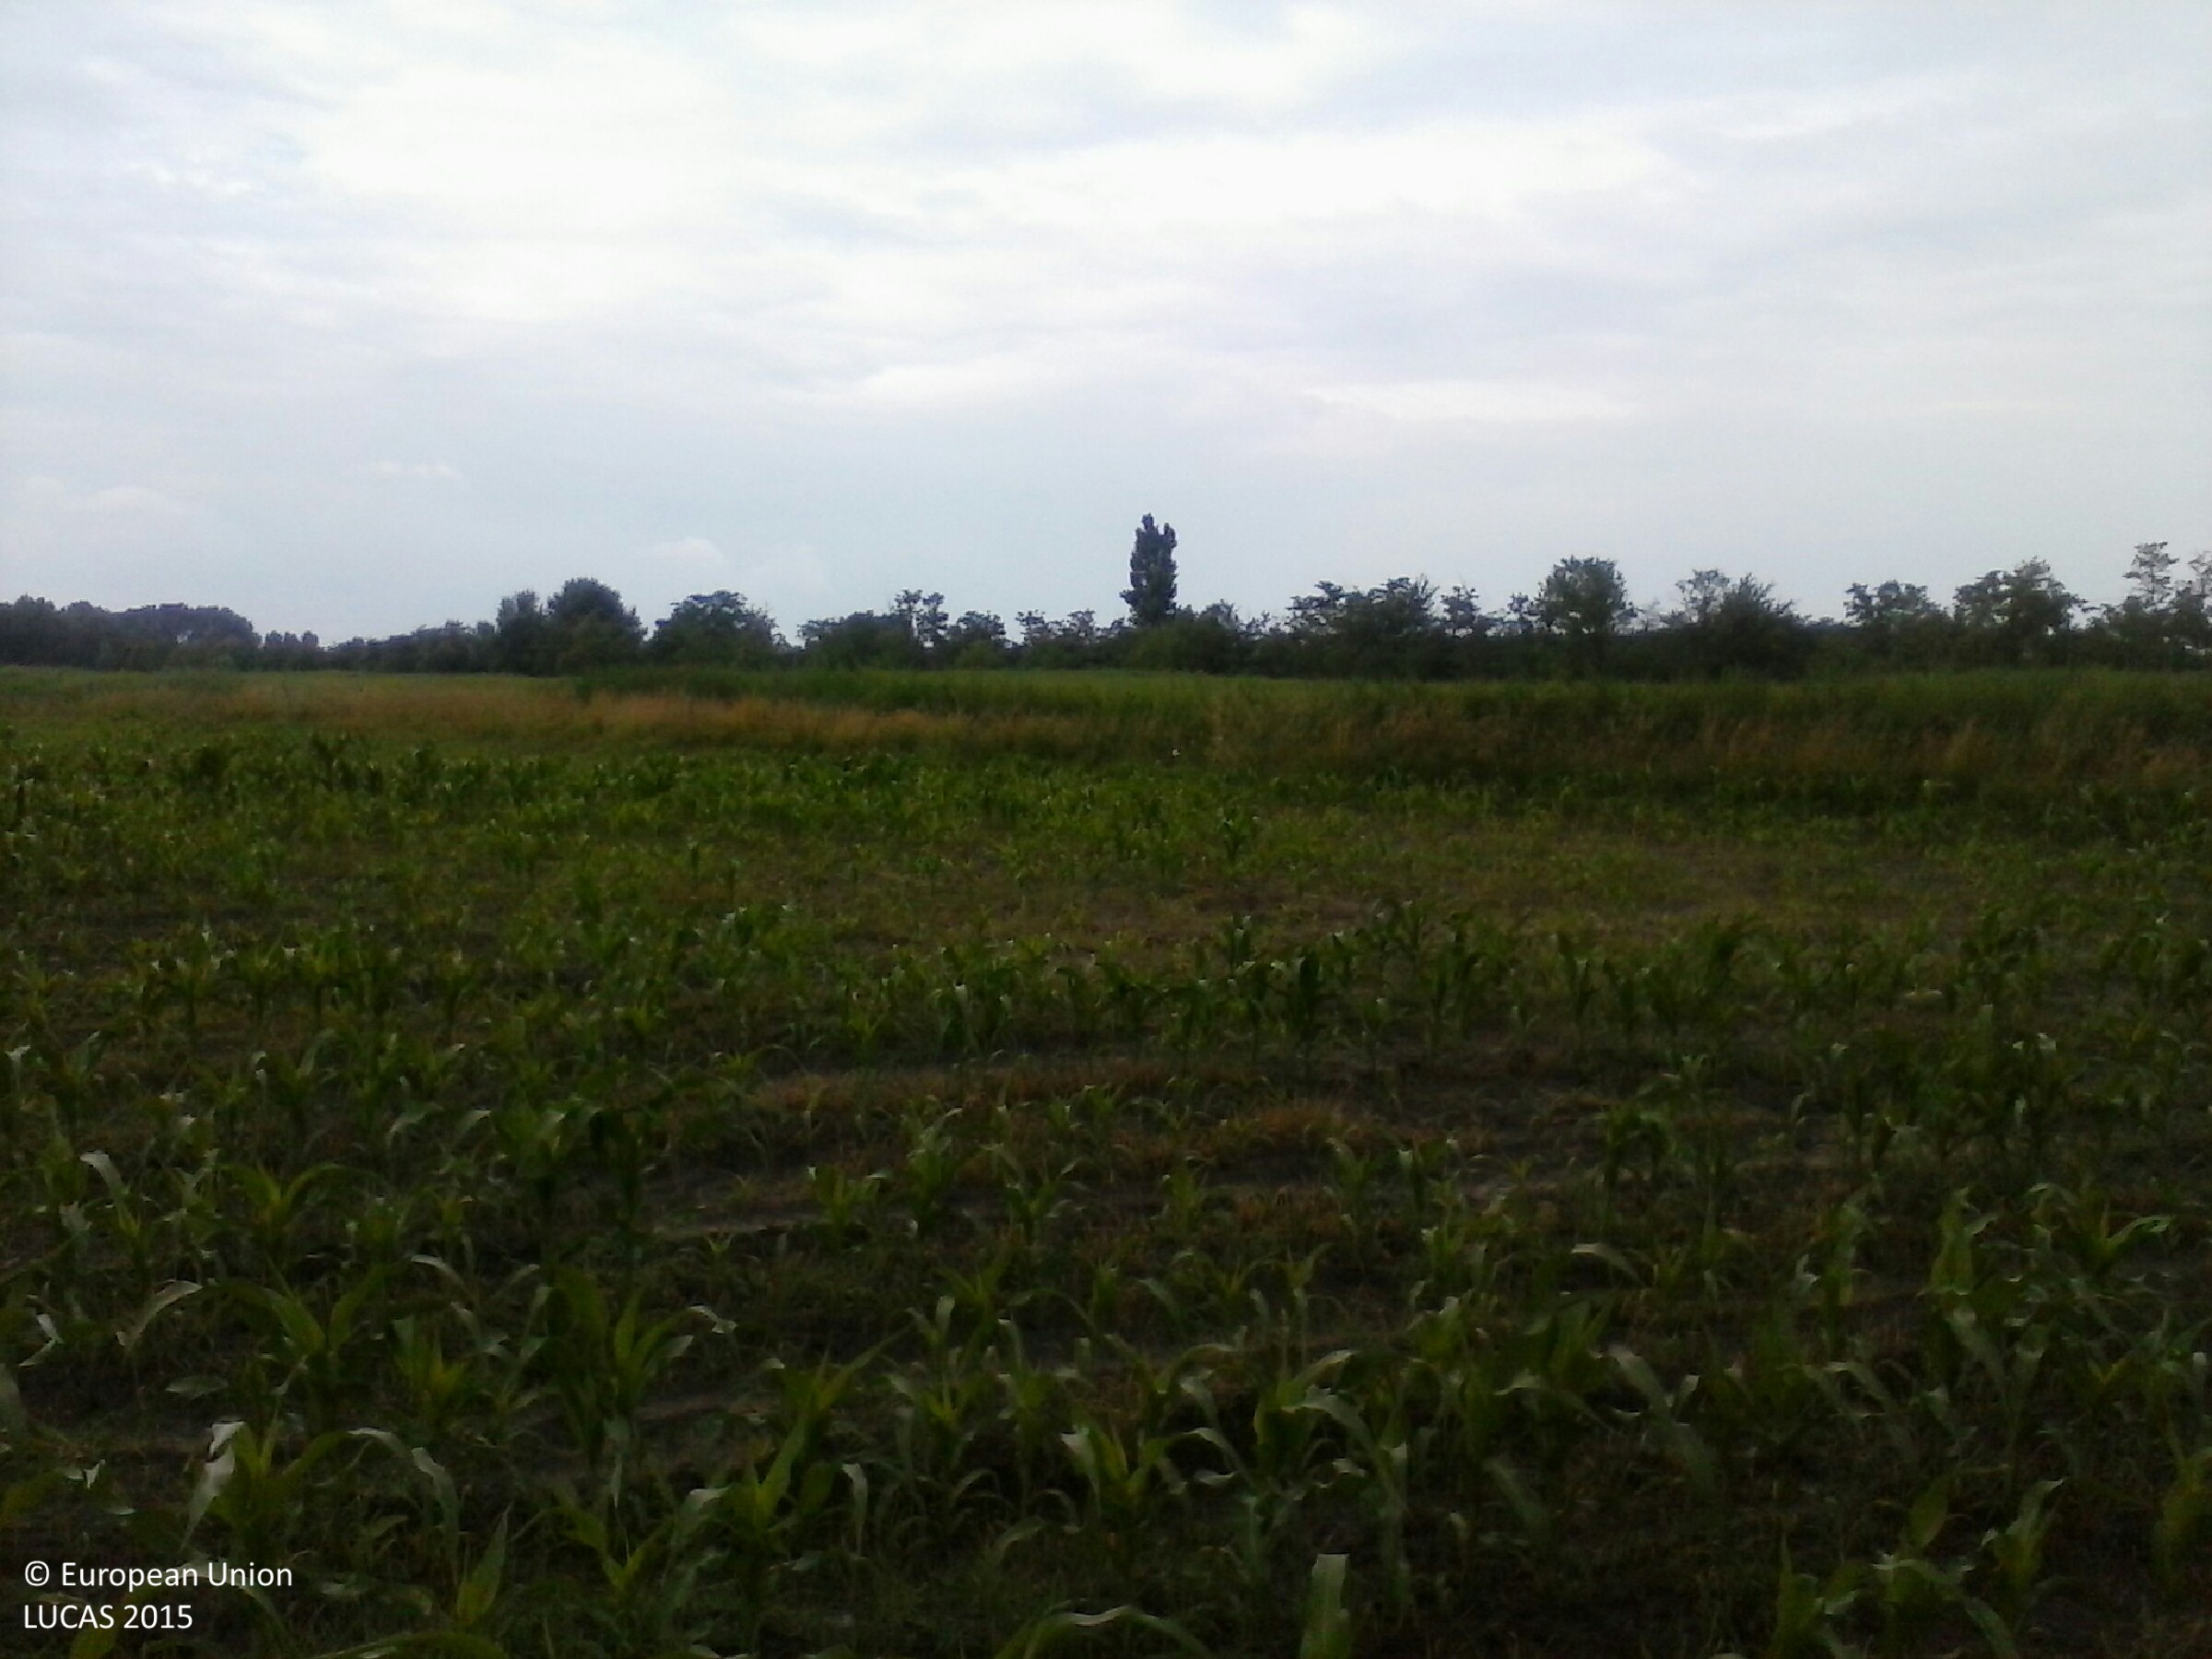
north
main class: Cropland
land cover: Maize
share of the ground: 50 - 75 %
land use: Agriculture (excluding fallow land and kitchen gardens)
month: June
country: HU
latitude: 46.4029
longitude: 20.0502
